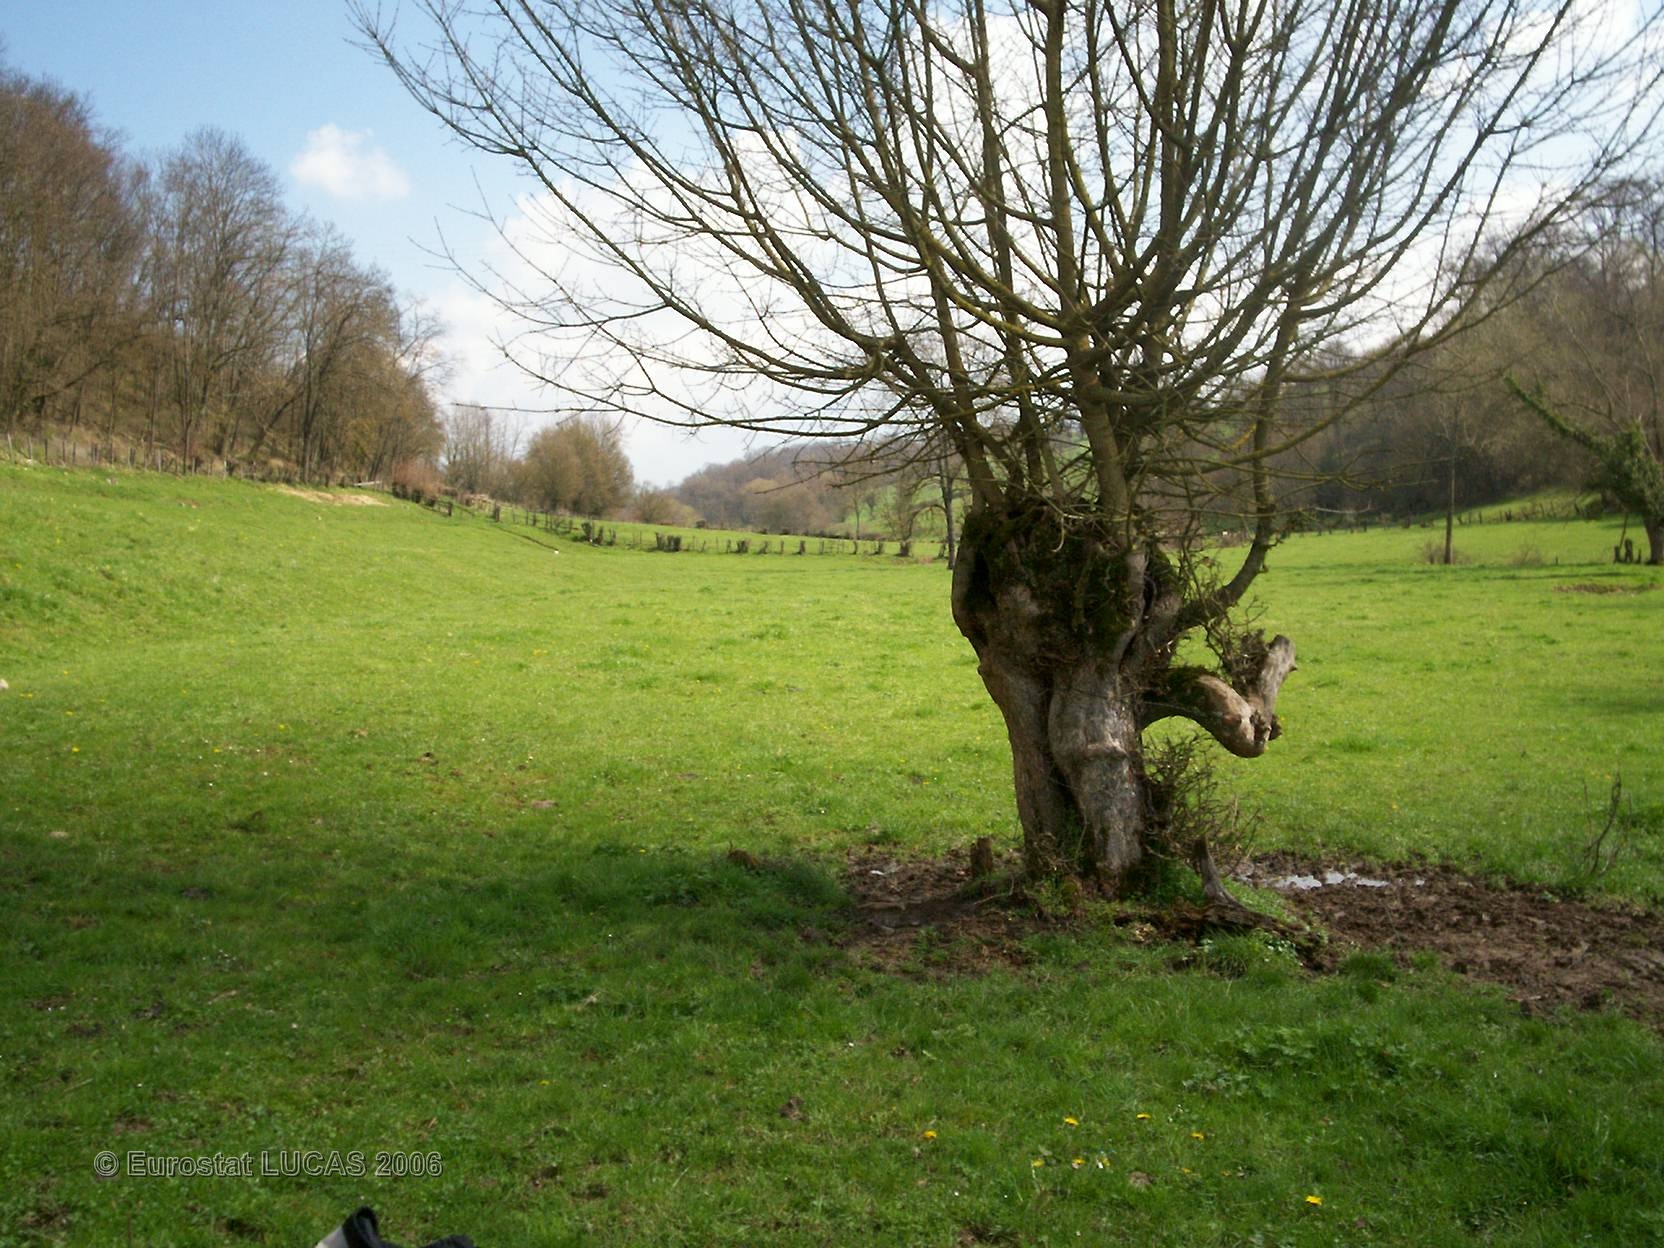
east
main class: Grassland
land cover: Grassland with sparse tree/shrub cover
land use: Agriculture (excluding fallow land and kitchen gardens)
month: April
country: FR
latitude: 46.2231
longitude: 4.0763
